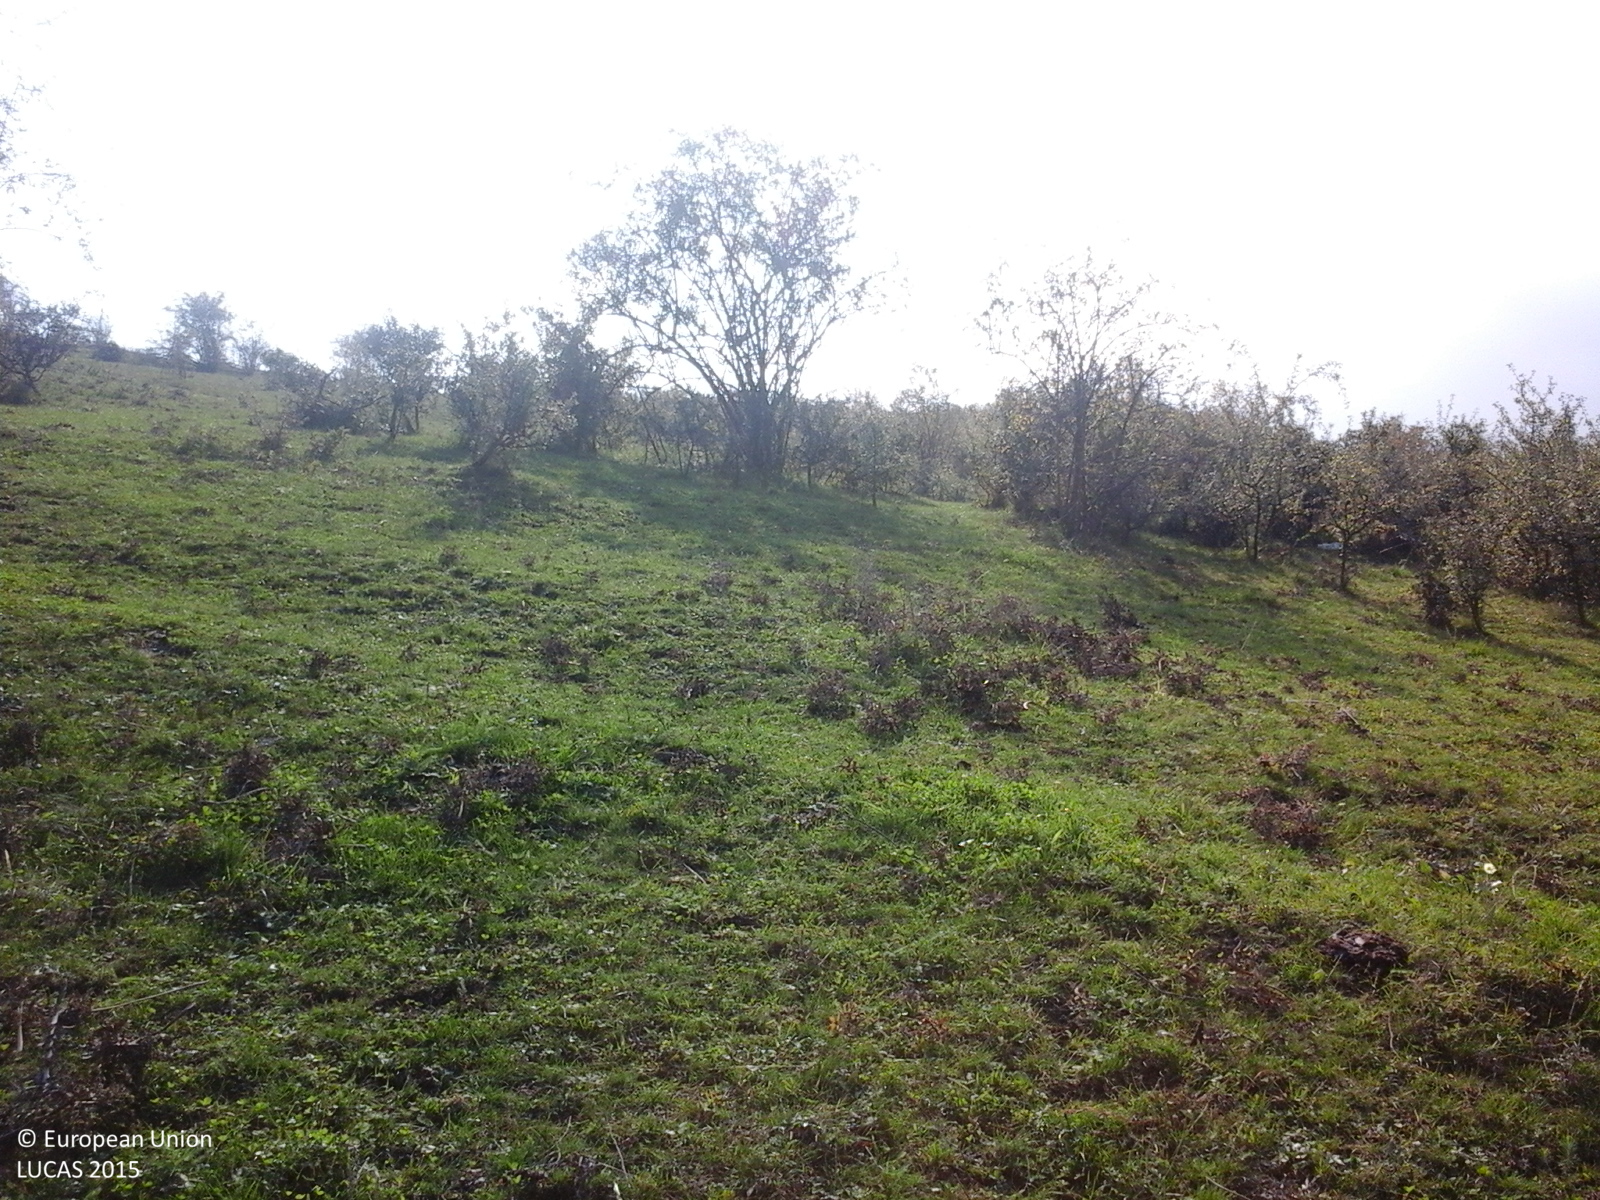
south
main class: Grassland
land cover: Grassland with sparse tree/shrub cover
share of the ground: > 75 %
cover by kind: herbaceous plants 85 %, shrubs 10 %, broadleaved forest trees 5 %
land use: Agriculture (excluding fallow land and kitchen gardens)
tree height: > 5 m
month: October
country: RO
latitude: 46.1423
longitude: 23.5426
